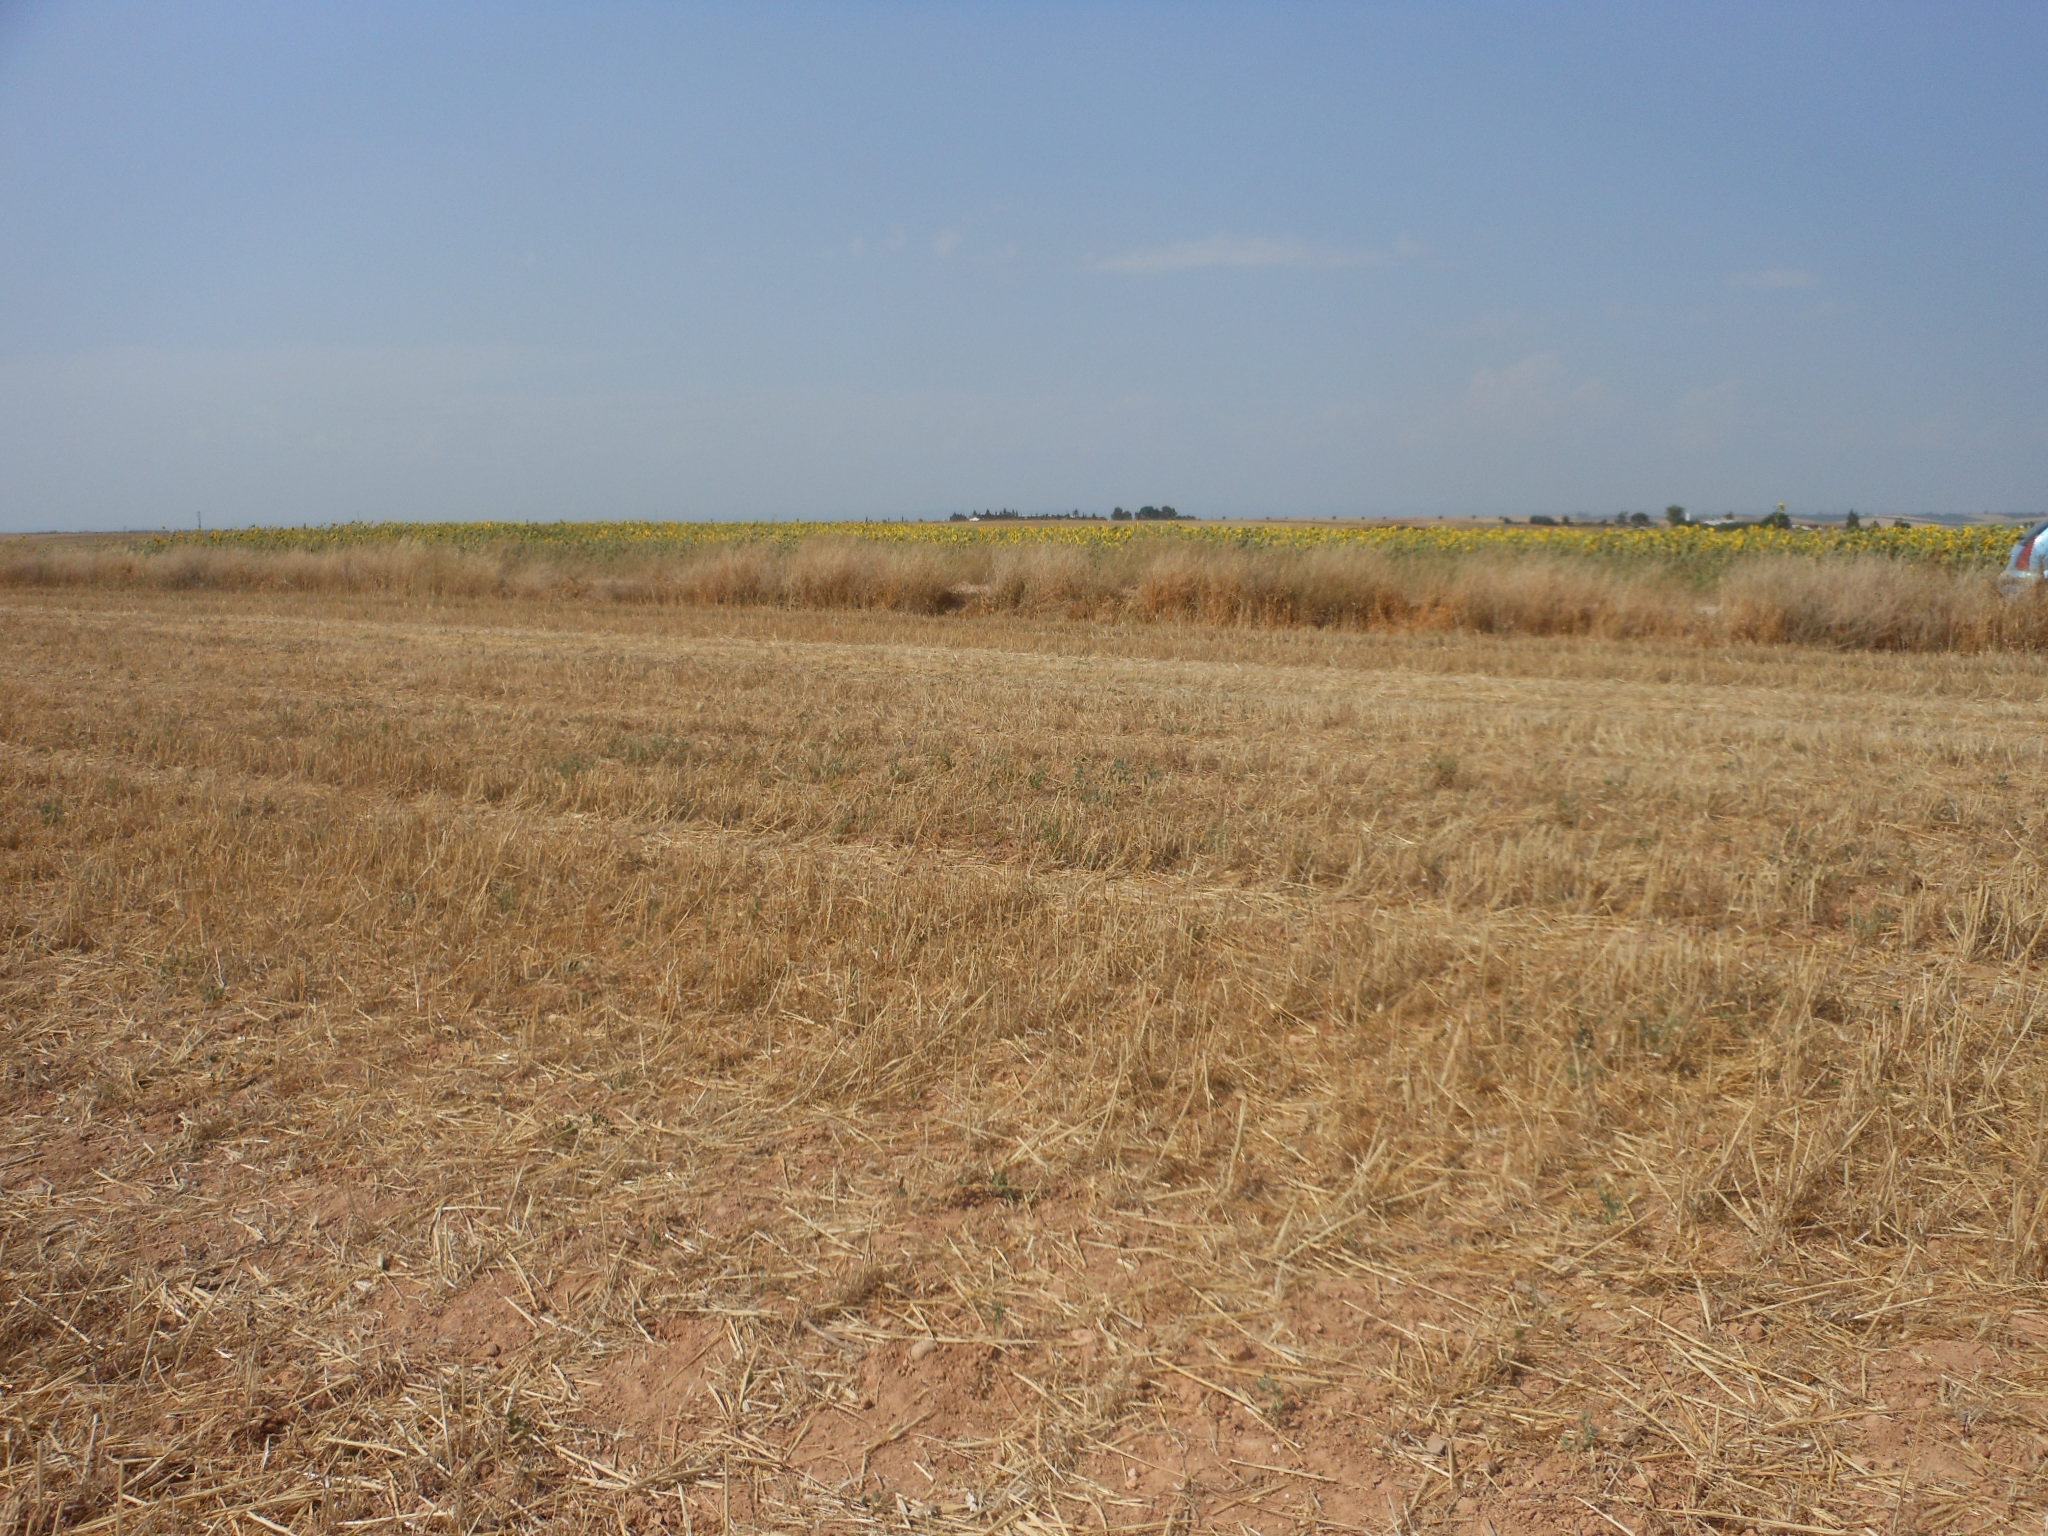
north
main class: Cropland
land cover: Durum wheat
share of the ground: < 10 %
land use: Agriculture (excluding fallow land and kitchen gardens)
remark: Harvested field
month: June
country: ES
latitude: 37.5465
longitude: -5.1006
